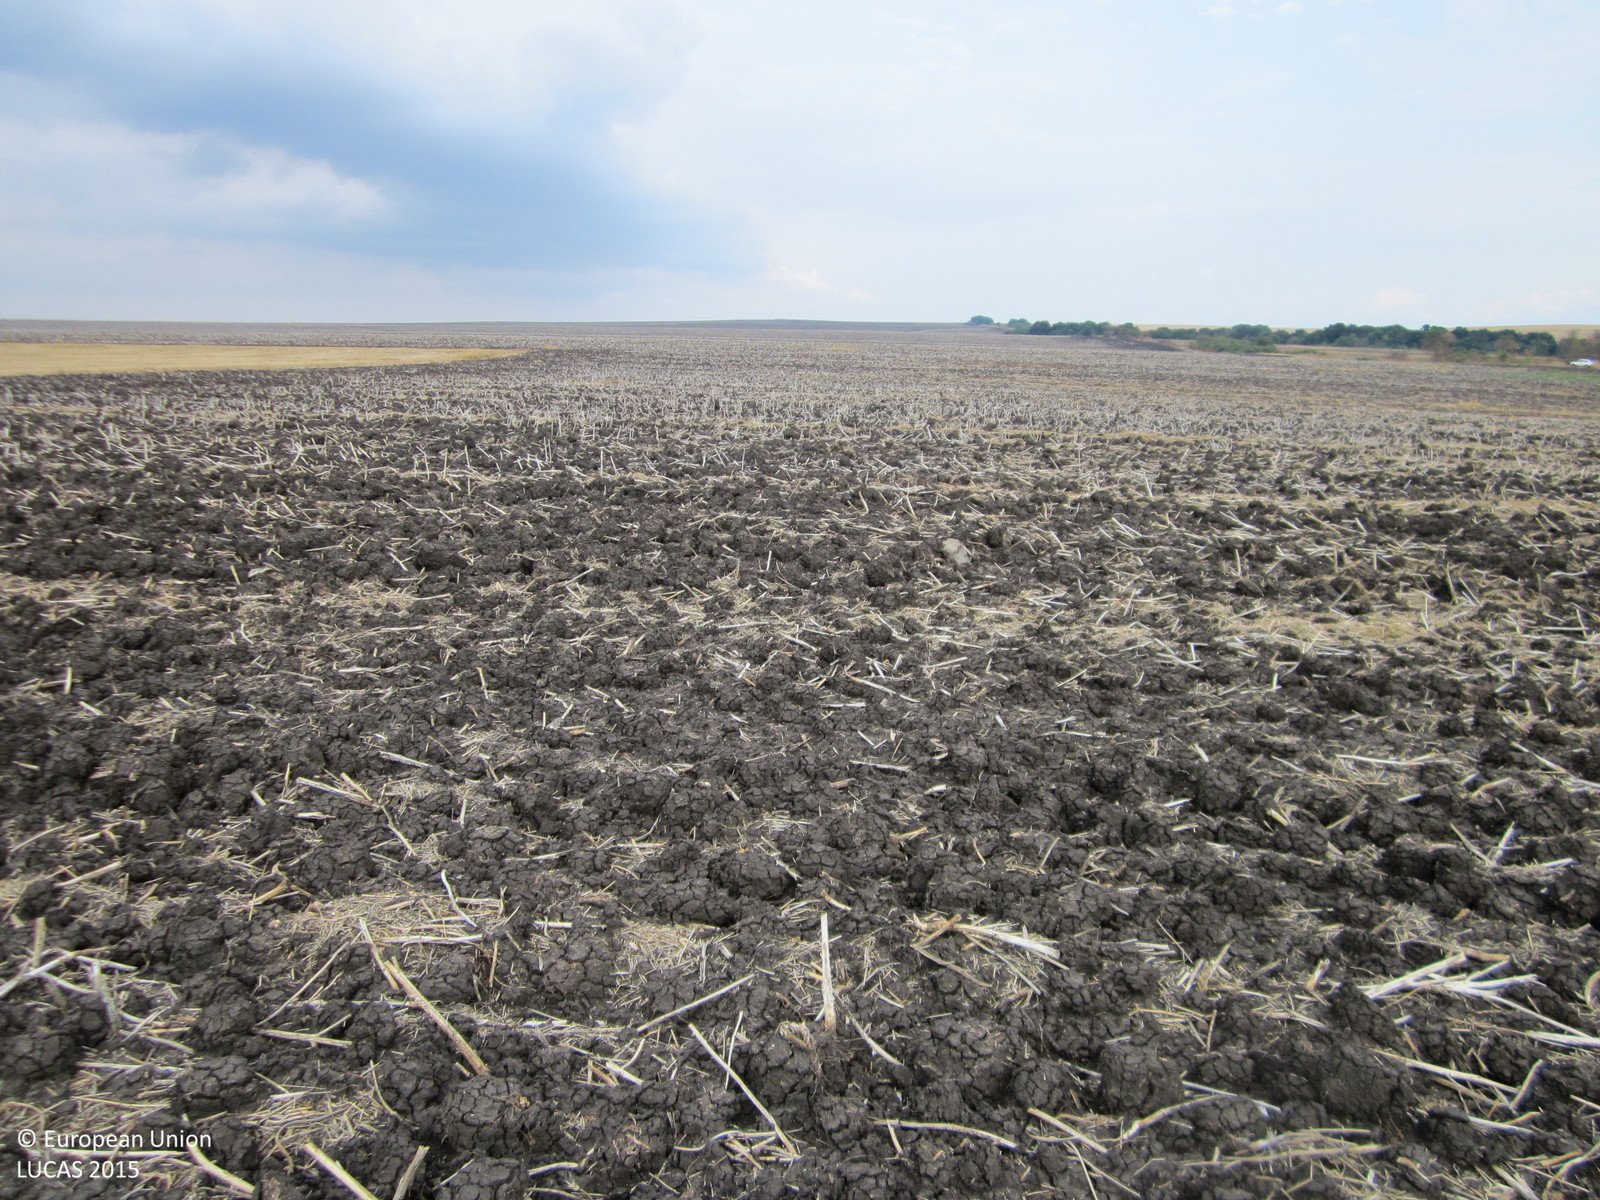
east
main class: Cropland
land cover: Sunflower
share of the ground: 10 - 25 %
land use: Agriculture (excluding fallow land and kitchen gardens)
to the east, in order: Sunflower
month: August
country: BG
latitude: 42.4575
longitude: 26.9946
